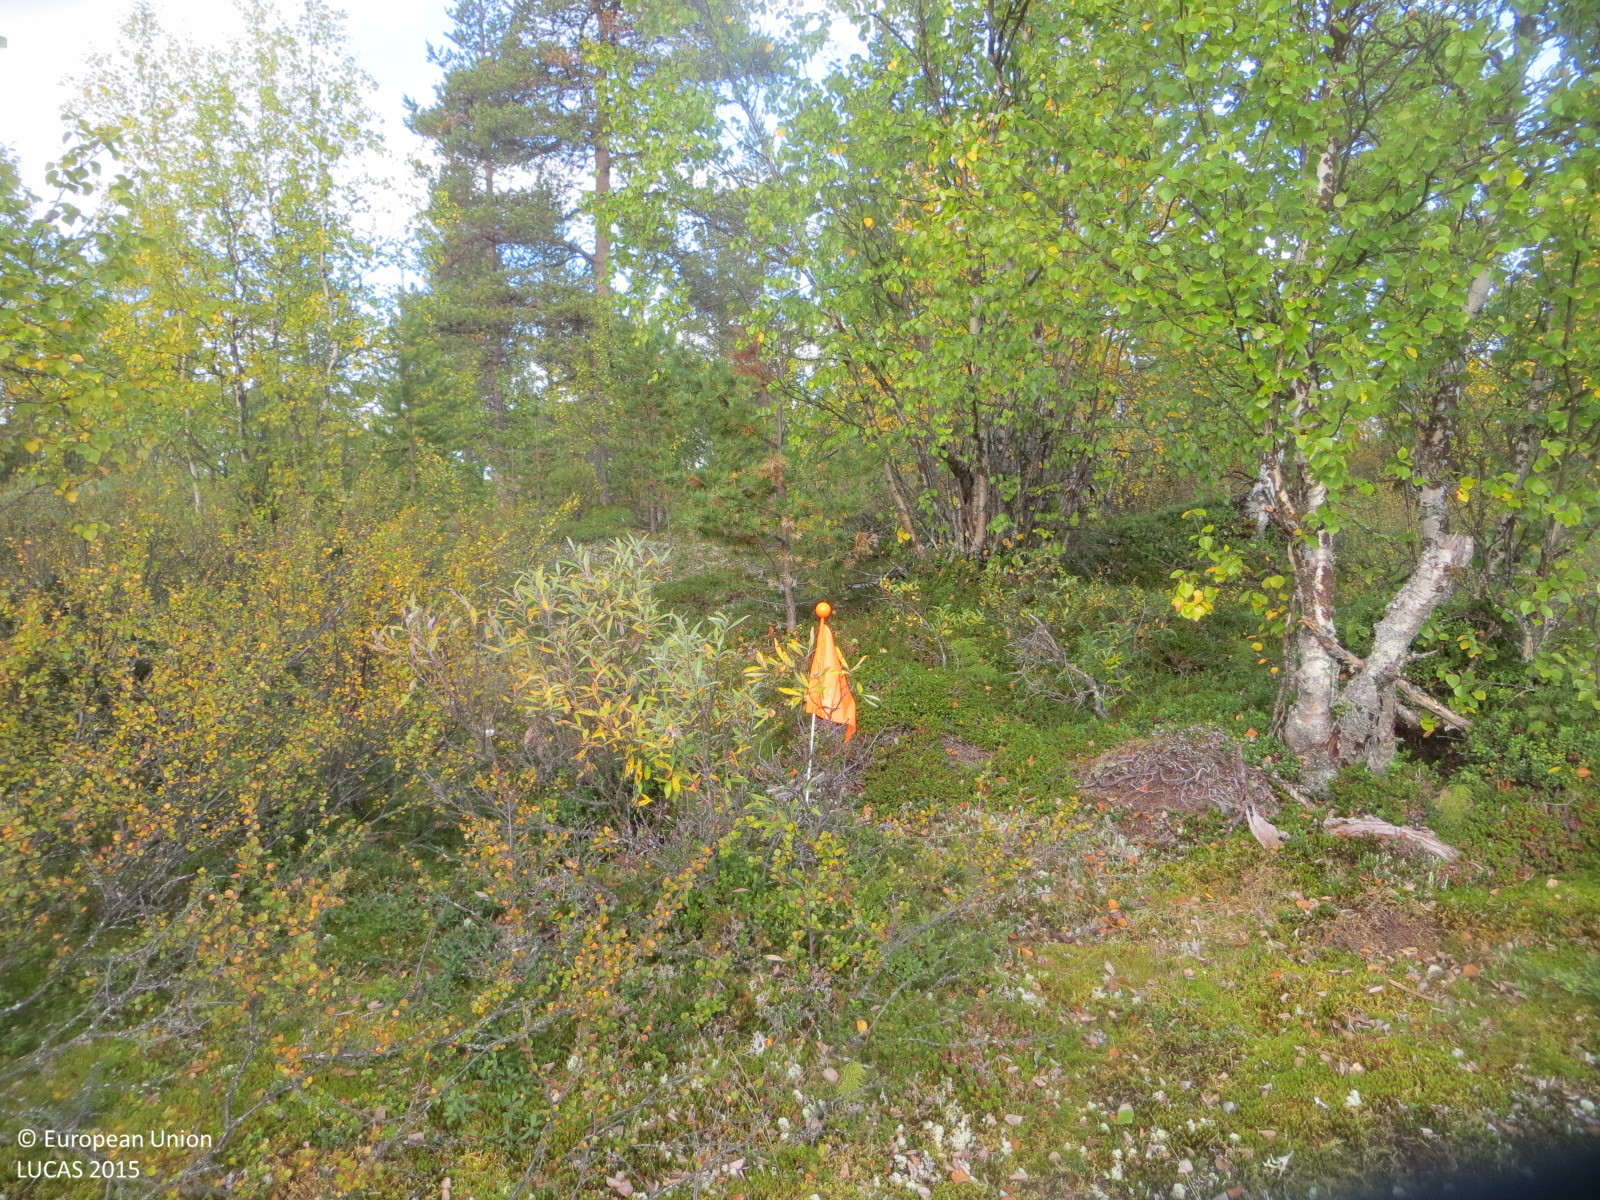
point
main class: Woodland
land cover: Pine dominated mixed woodland
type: boreal forest
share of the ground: 50 - 75 %
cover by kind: shrubs 50 %, broadleaved forest trees 35 %, coniferous forest trees 15 %
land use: Semi-natural and natural areas not in use
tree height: > 5 m
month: September
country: FI
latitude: 68.3999
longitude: 24.3028
